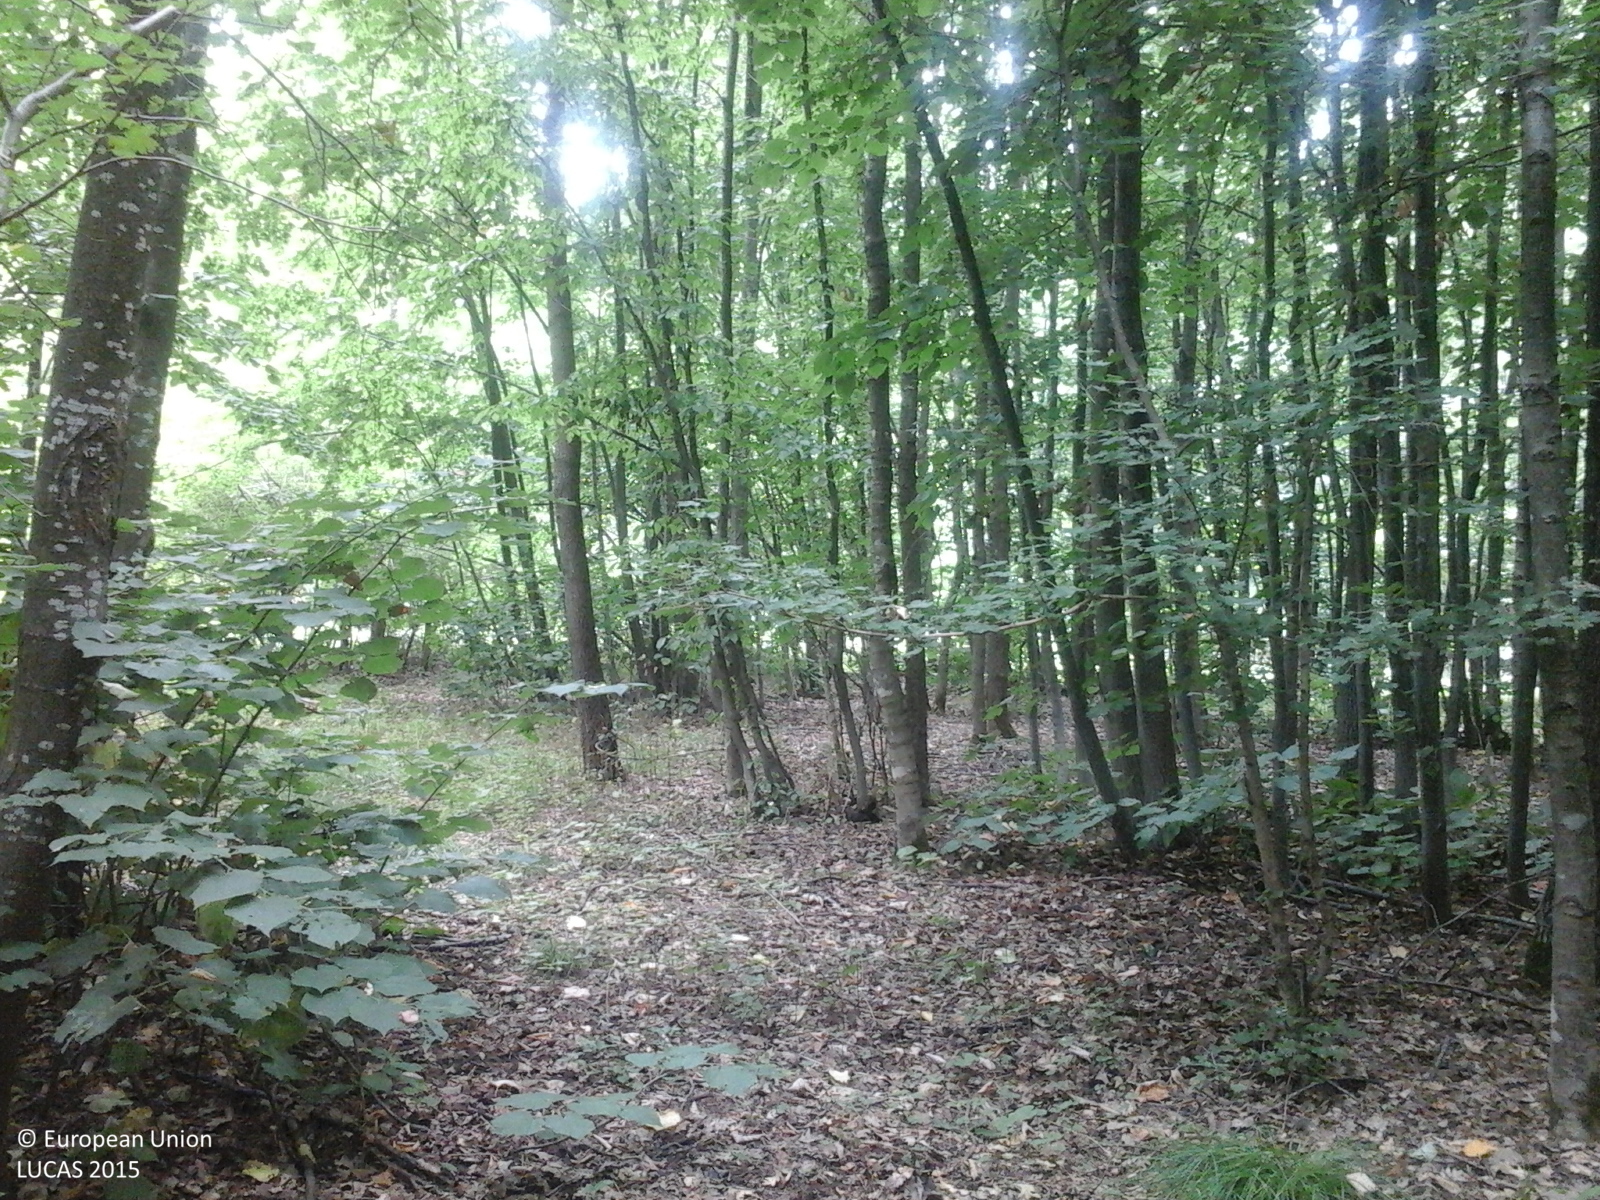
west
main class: Woodland
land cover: Broadleaved woodland
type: mesophytic deciduous forest
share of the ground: > 75 %
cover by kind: broadleaved forest trees 100 %
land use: Forestry
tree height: > 5 m
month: July
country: RO
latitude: 44.4756
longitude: 25.6461
